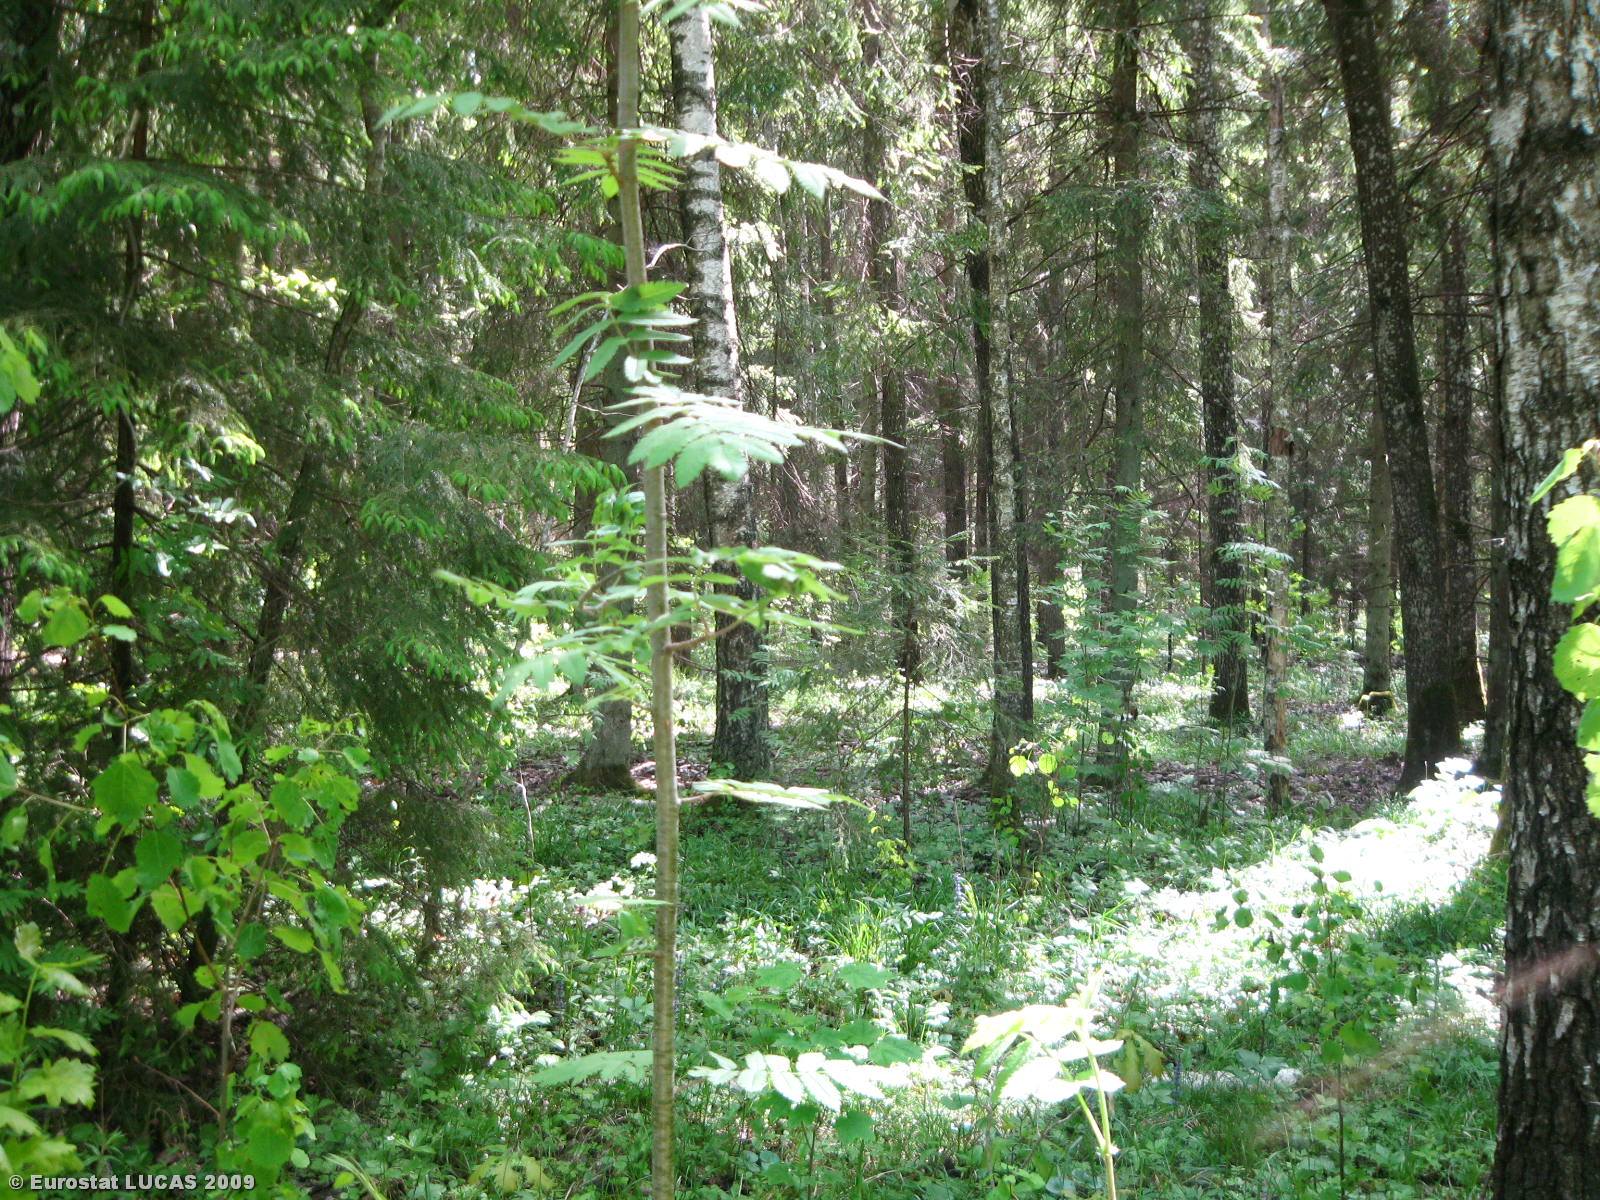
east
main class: Woodland
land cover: Mixed woodland
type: hemiboreal forest and nemoral coniferous forest and mixed broadleaved-coniferous forest
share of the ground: > 75 %
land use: Forestry
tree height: > 5 m
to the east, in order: Mixed woodland; Broadleaved woodland; Mixed woodland
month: May
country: LT
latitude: 56.0258
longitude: 24.0969
